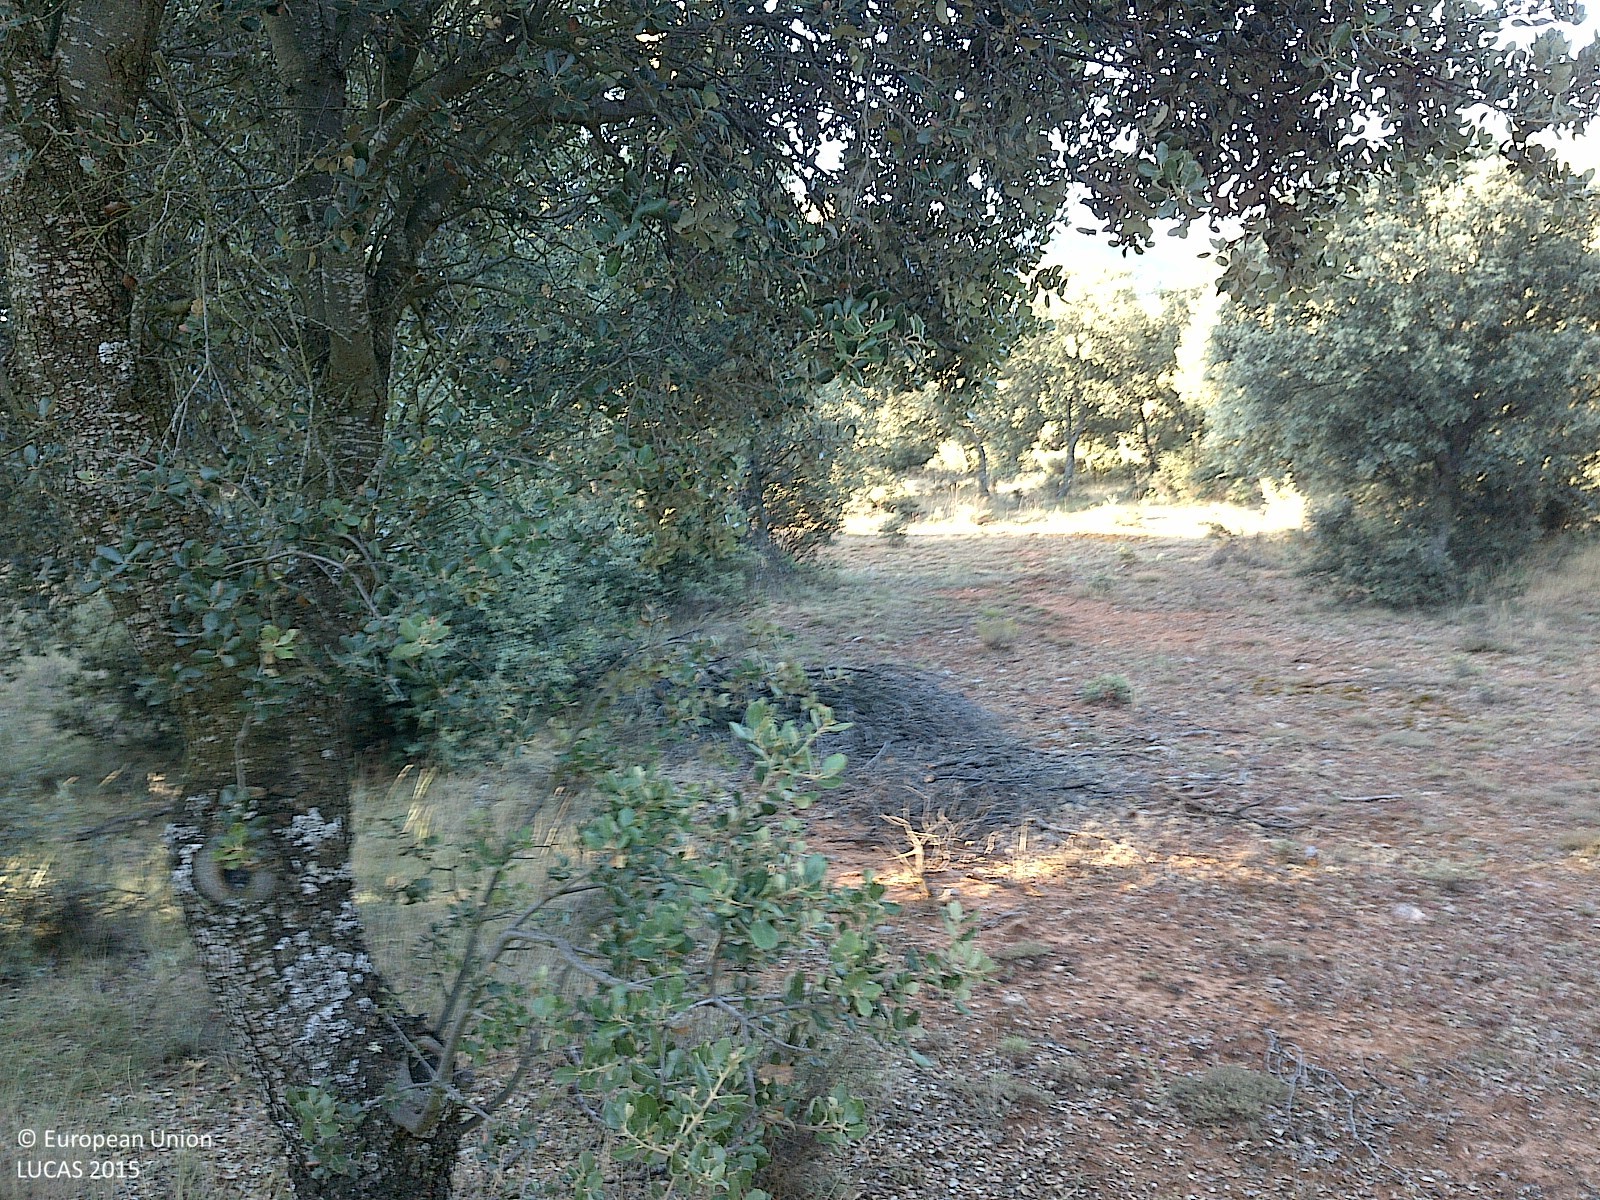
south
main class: Woodland
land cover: Broadleaved woodland
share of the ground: > 75 %
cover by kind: broadleaved forest trees 80 %, herbaceous plants 15 %, shrubs 5 %
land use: Forestry
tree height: < 5 m
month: July
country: ES
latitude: 41.7790
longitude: -1.9555
